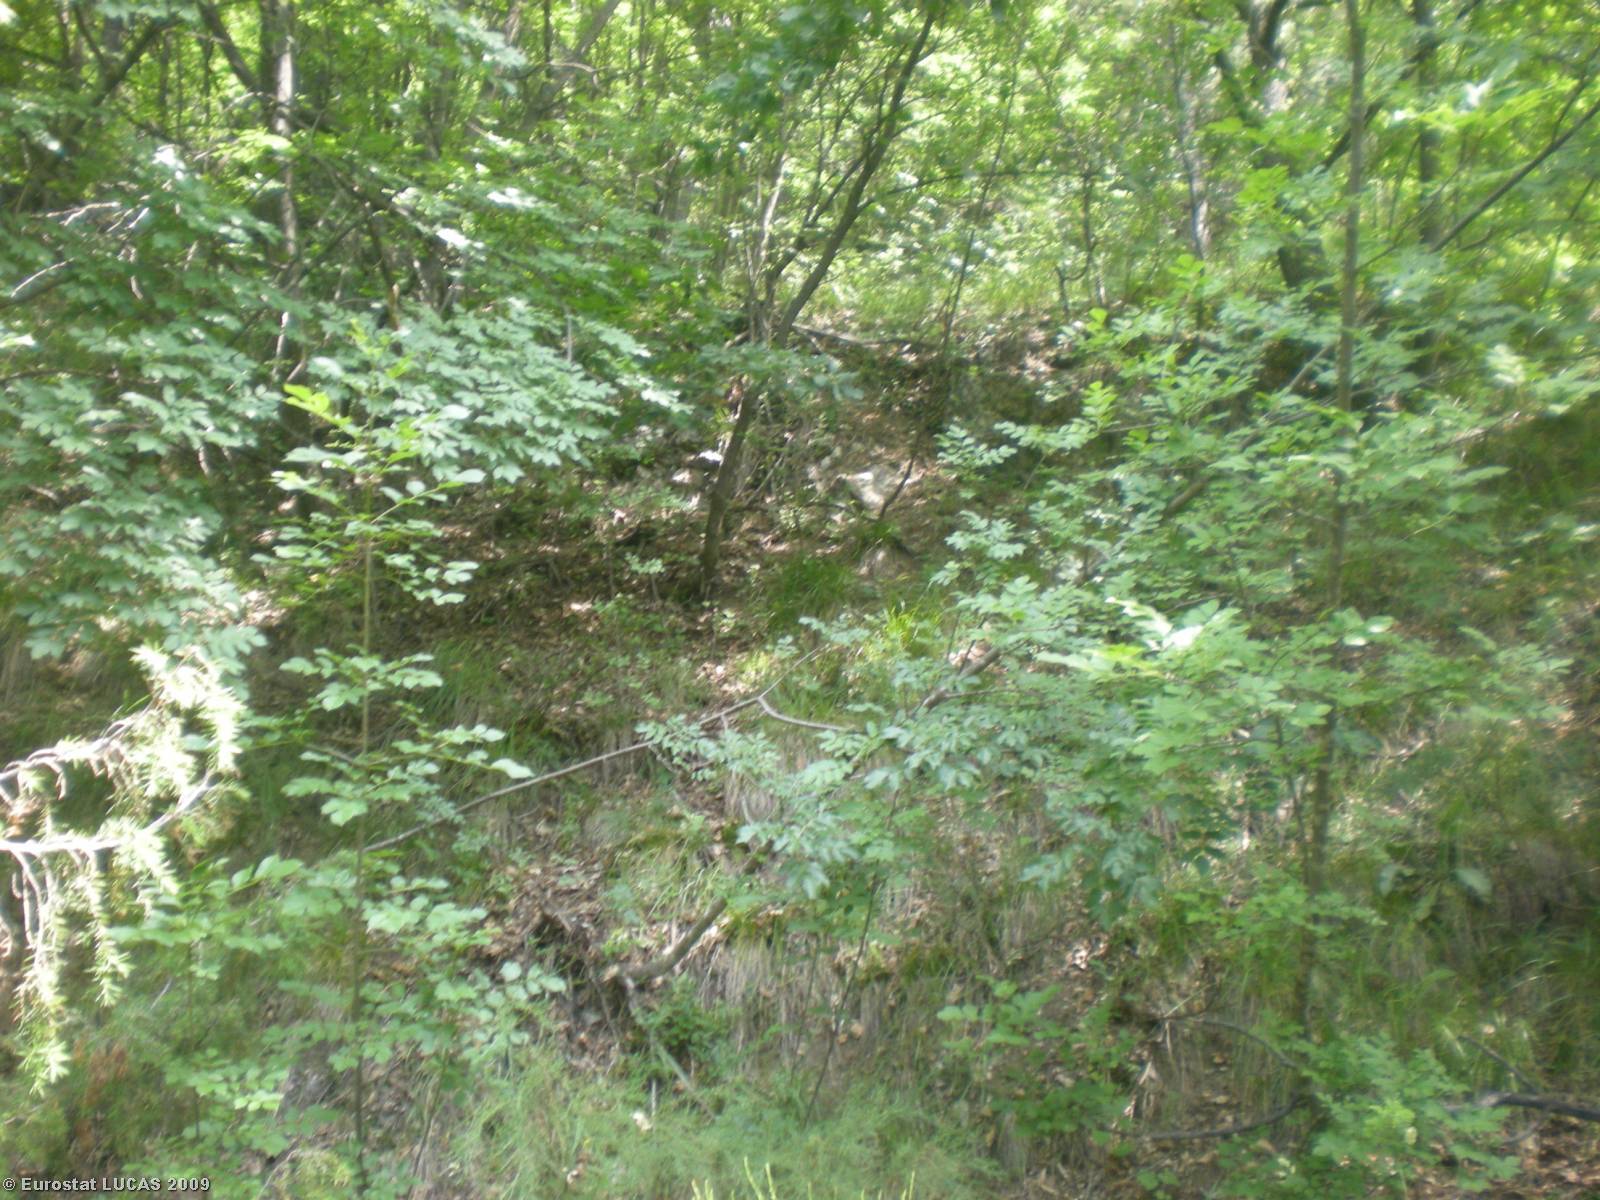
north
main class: Woodland
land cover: Broadleaved woodland
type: mesophytic deciduous forest
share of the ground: > 75 %
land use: Agriculture (excluding fallow land and kitchen gardens)
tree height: > 5 m
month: June
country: IT
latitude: 44.3124
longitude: 7.1851
